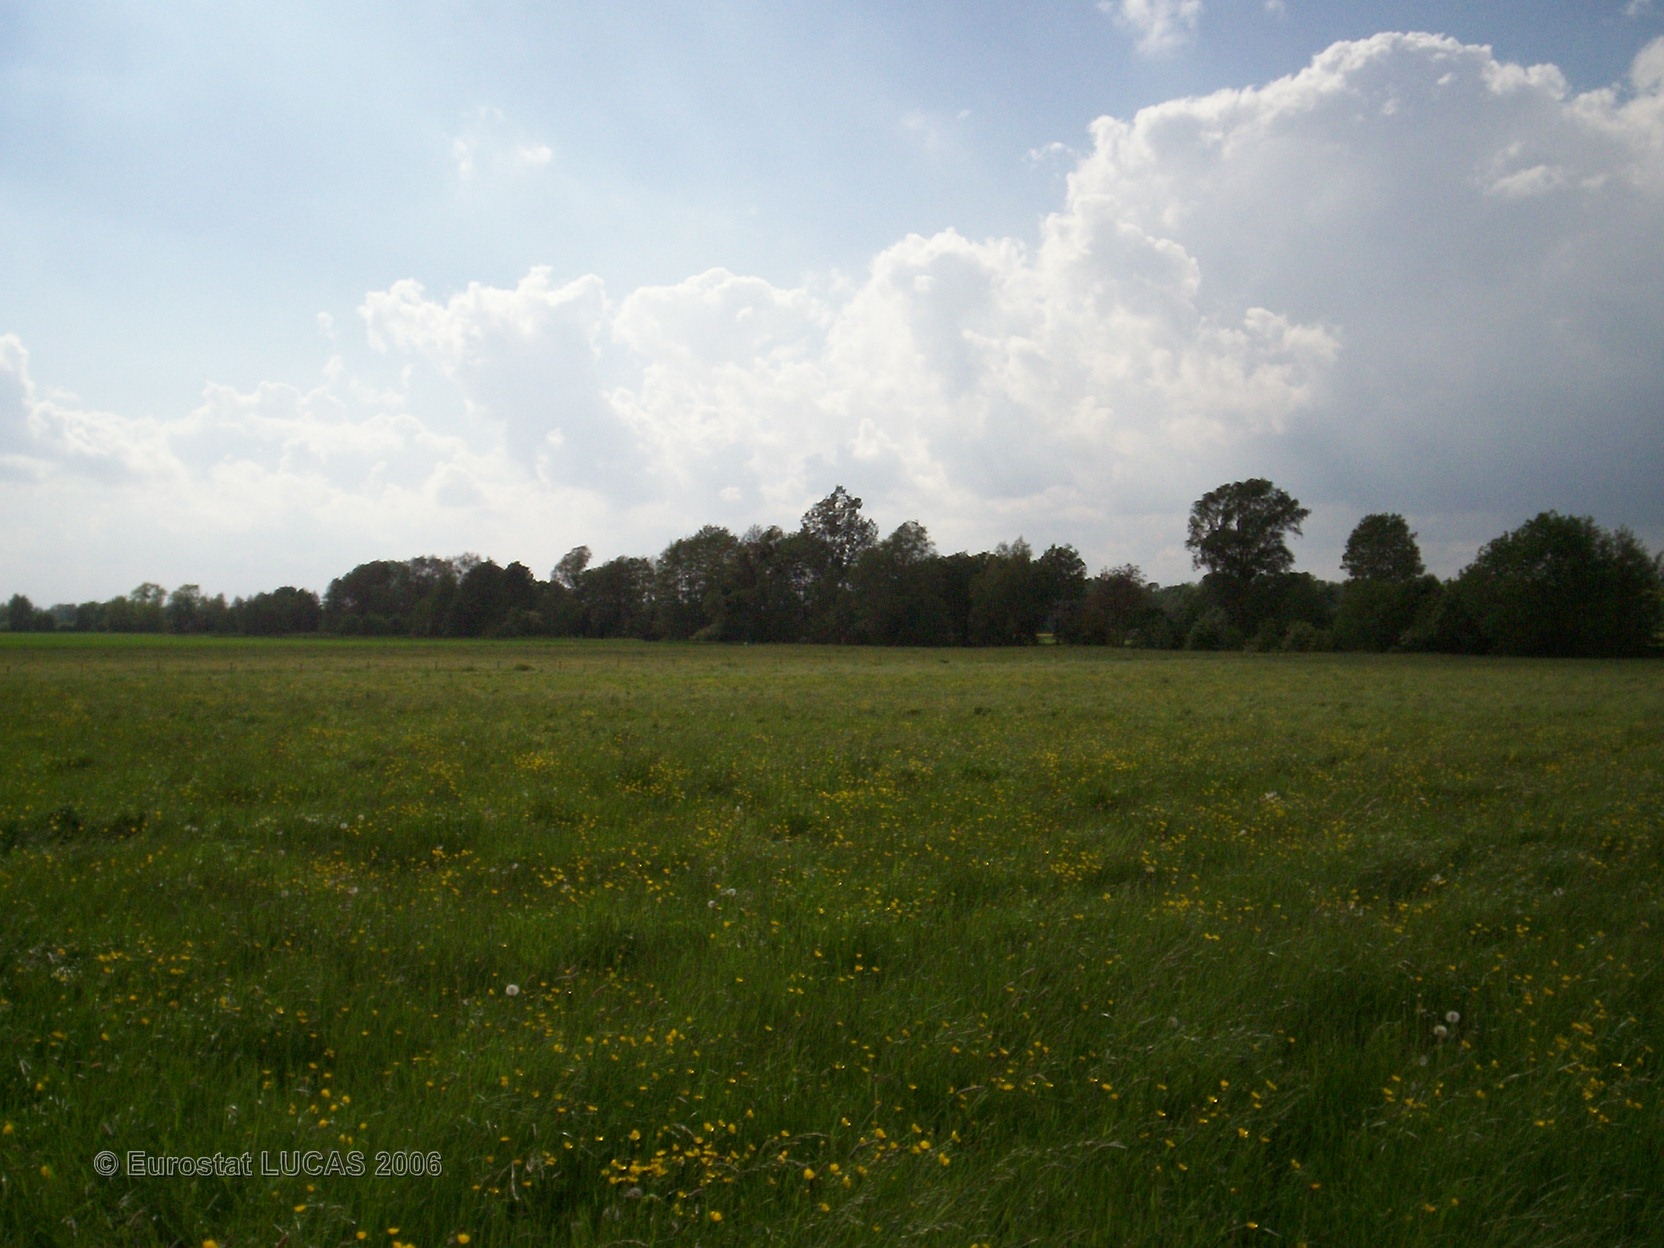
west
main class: Grassland
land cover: Grassland without tree/shrub cover
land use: Agriculture (excluding fallow land and kitchen gardens)
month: May
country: FR
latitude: 49.5570
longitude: 4.3417
